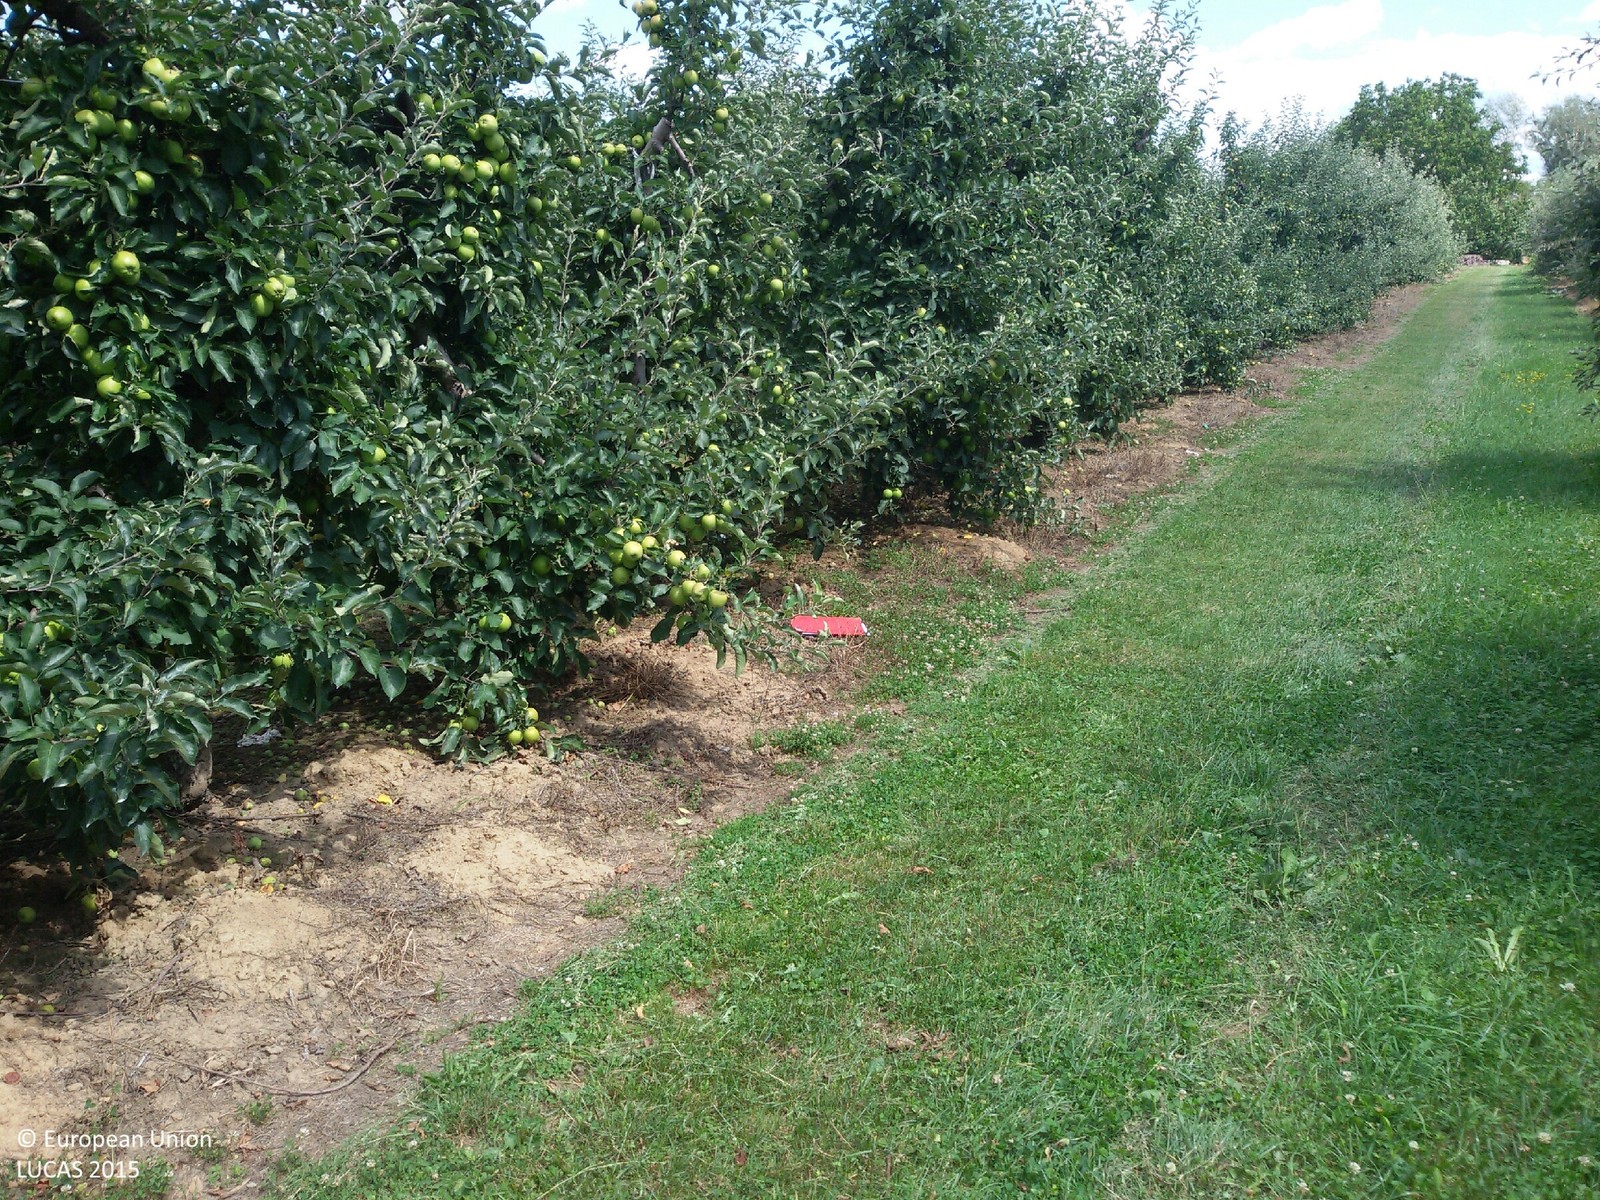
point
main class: Cropland
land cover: Apple fruit
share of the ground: > 75 %
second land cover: Grassland without tree/shrub cover
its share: > 75 %
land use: Agriculture (excluding fallow land and kitchen gardens)
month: July
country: PL
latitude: 50.5843
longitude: 21.6483
